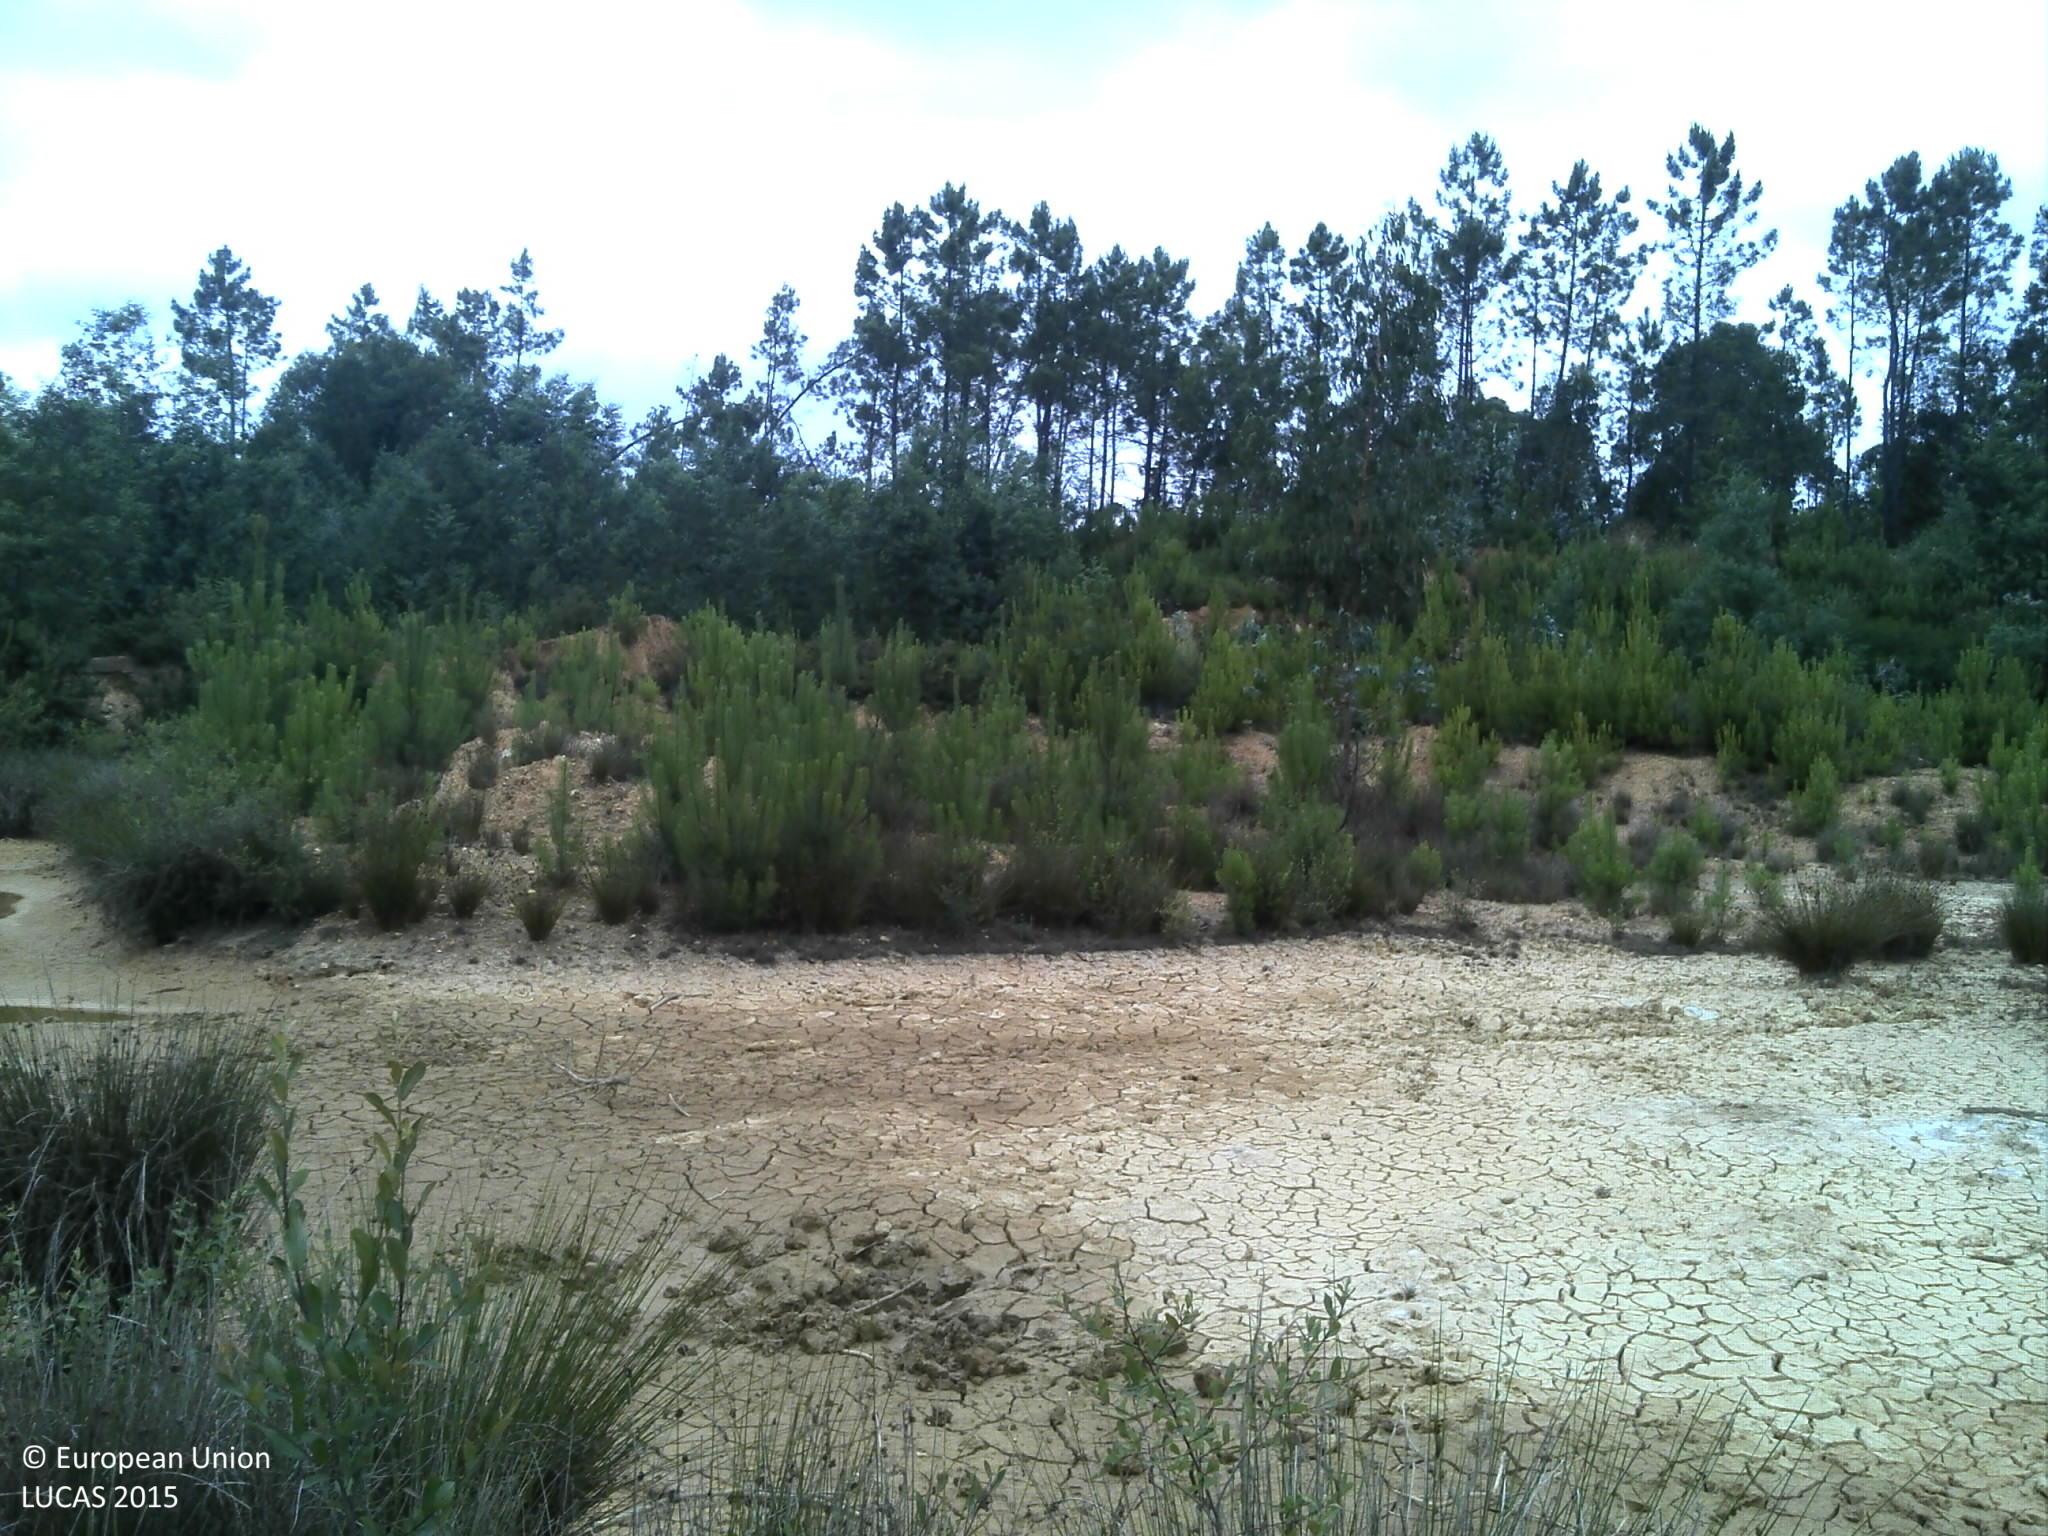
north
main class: Woodland
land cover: Pine dominated coniferous woodland
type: coniferous forest of the mediterranean region
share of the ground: 50 - 75 %
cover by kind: coniferous forest trees 50 %, unconsolidated bare surface 30 %, shrubs 20 %
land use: Semi-natural and natural areas not in use
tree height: < 5 m
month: June
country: PT
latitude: 40.5046
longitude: -8.4146
